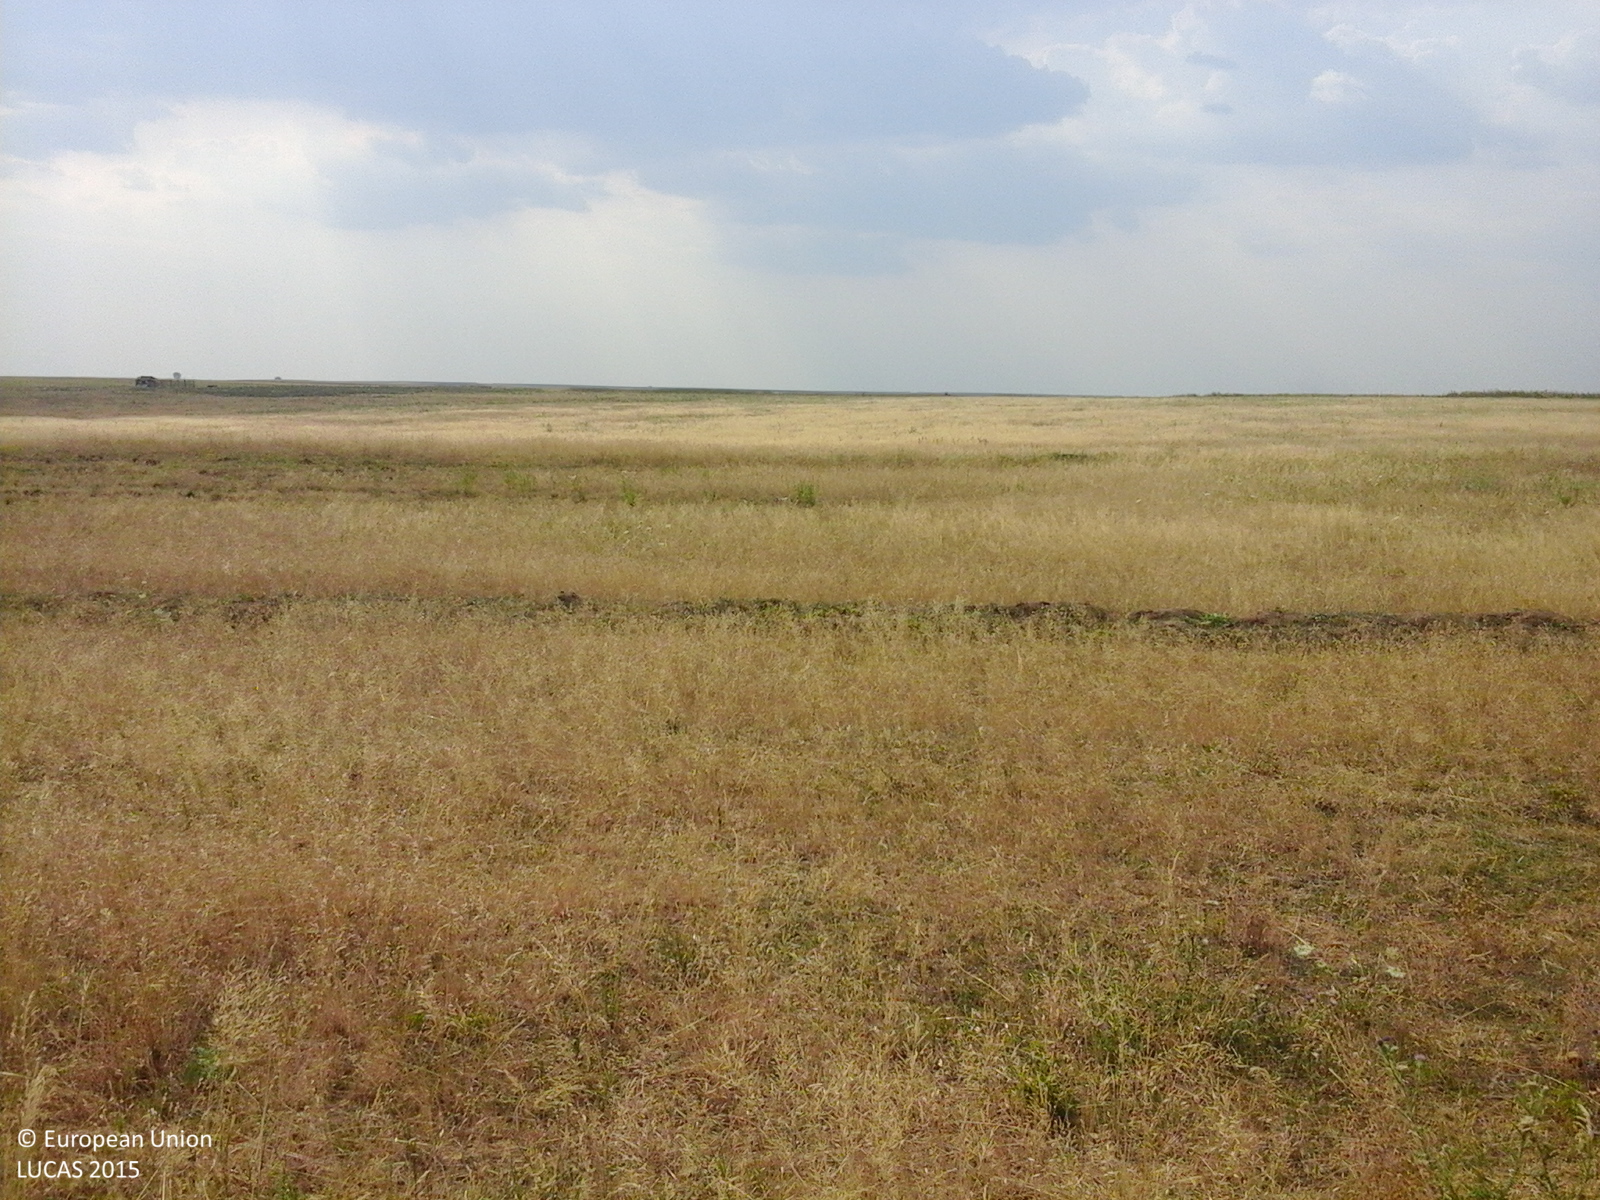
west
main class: Grassland
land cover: Grassland without tree/shrub cover
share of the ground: > 75 %
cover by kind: herbaceous plants 100 %
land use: Agriculture (excluding fallow land and kitchen gardens)
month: August
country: RO
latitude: 44.3131
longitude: 23.1474
